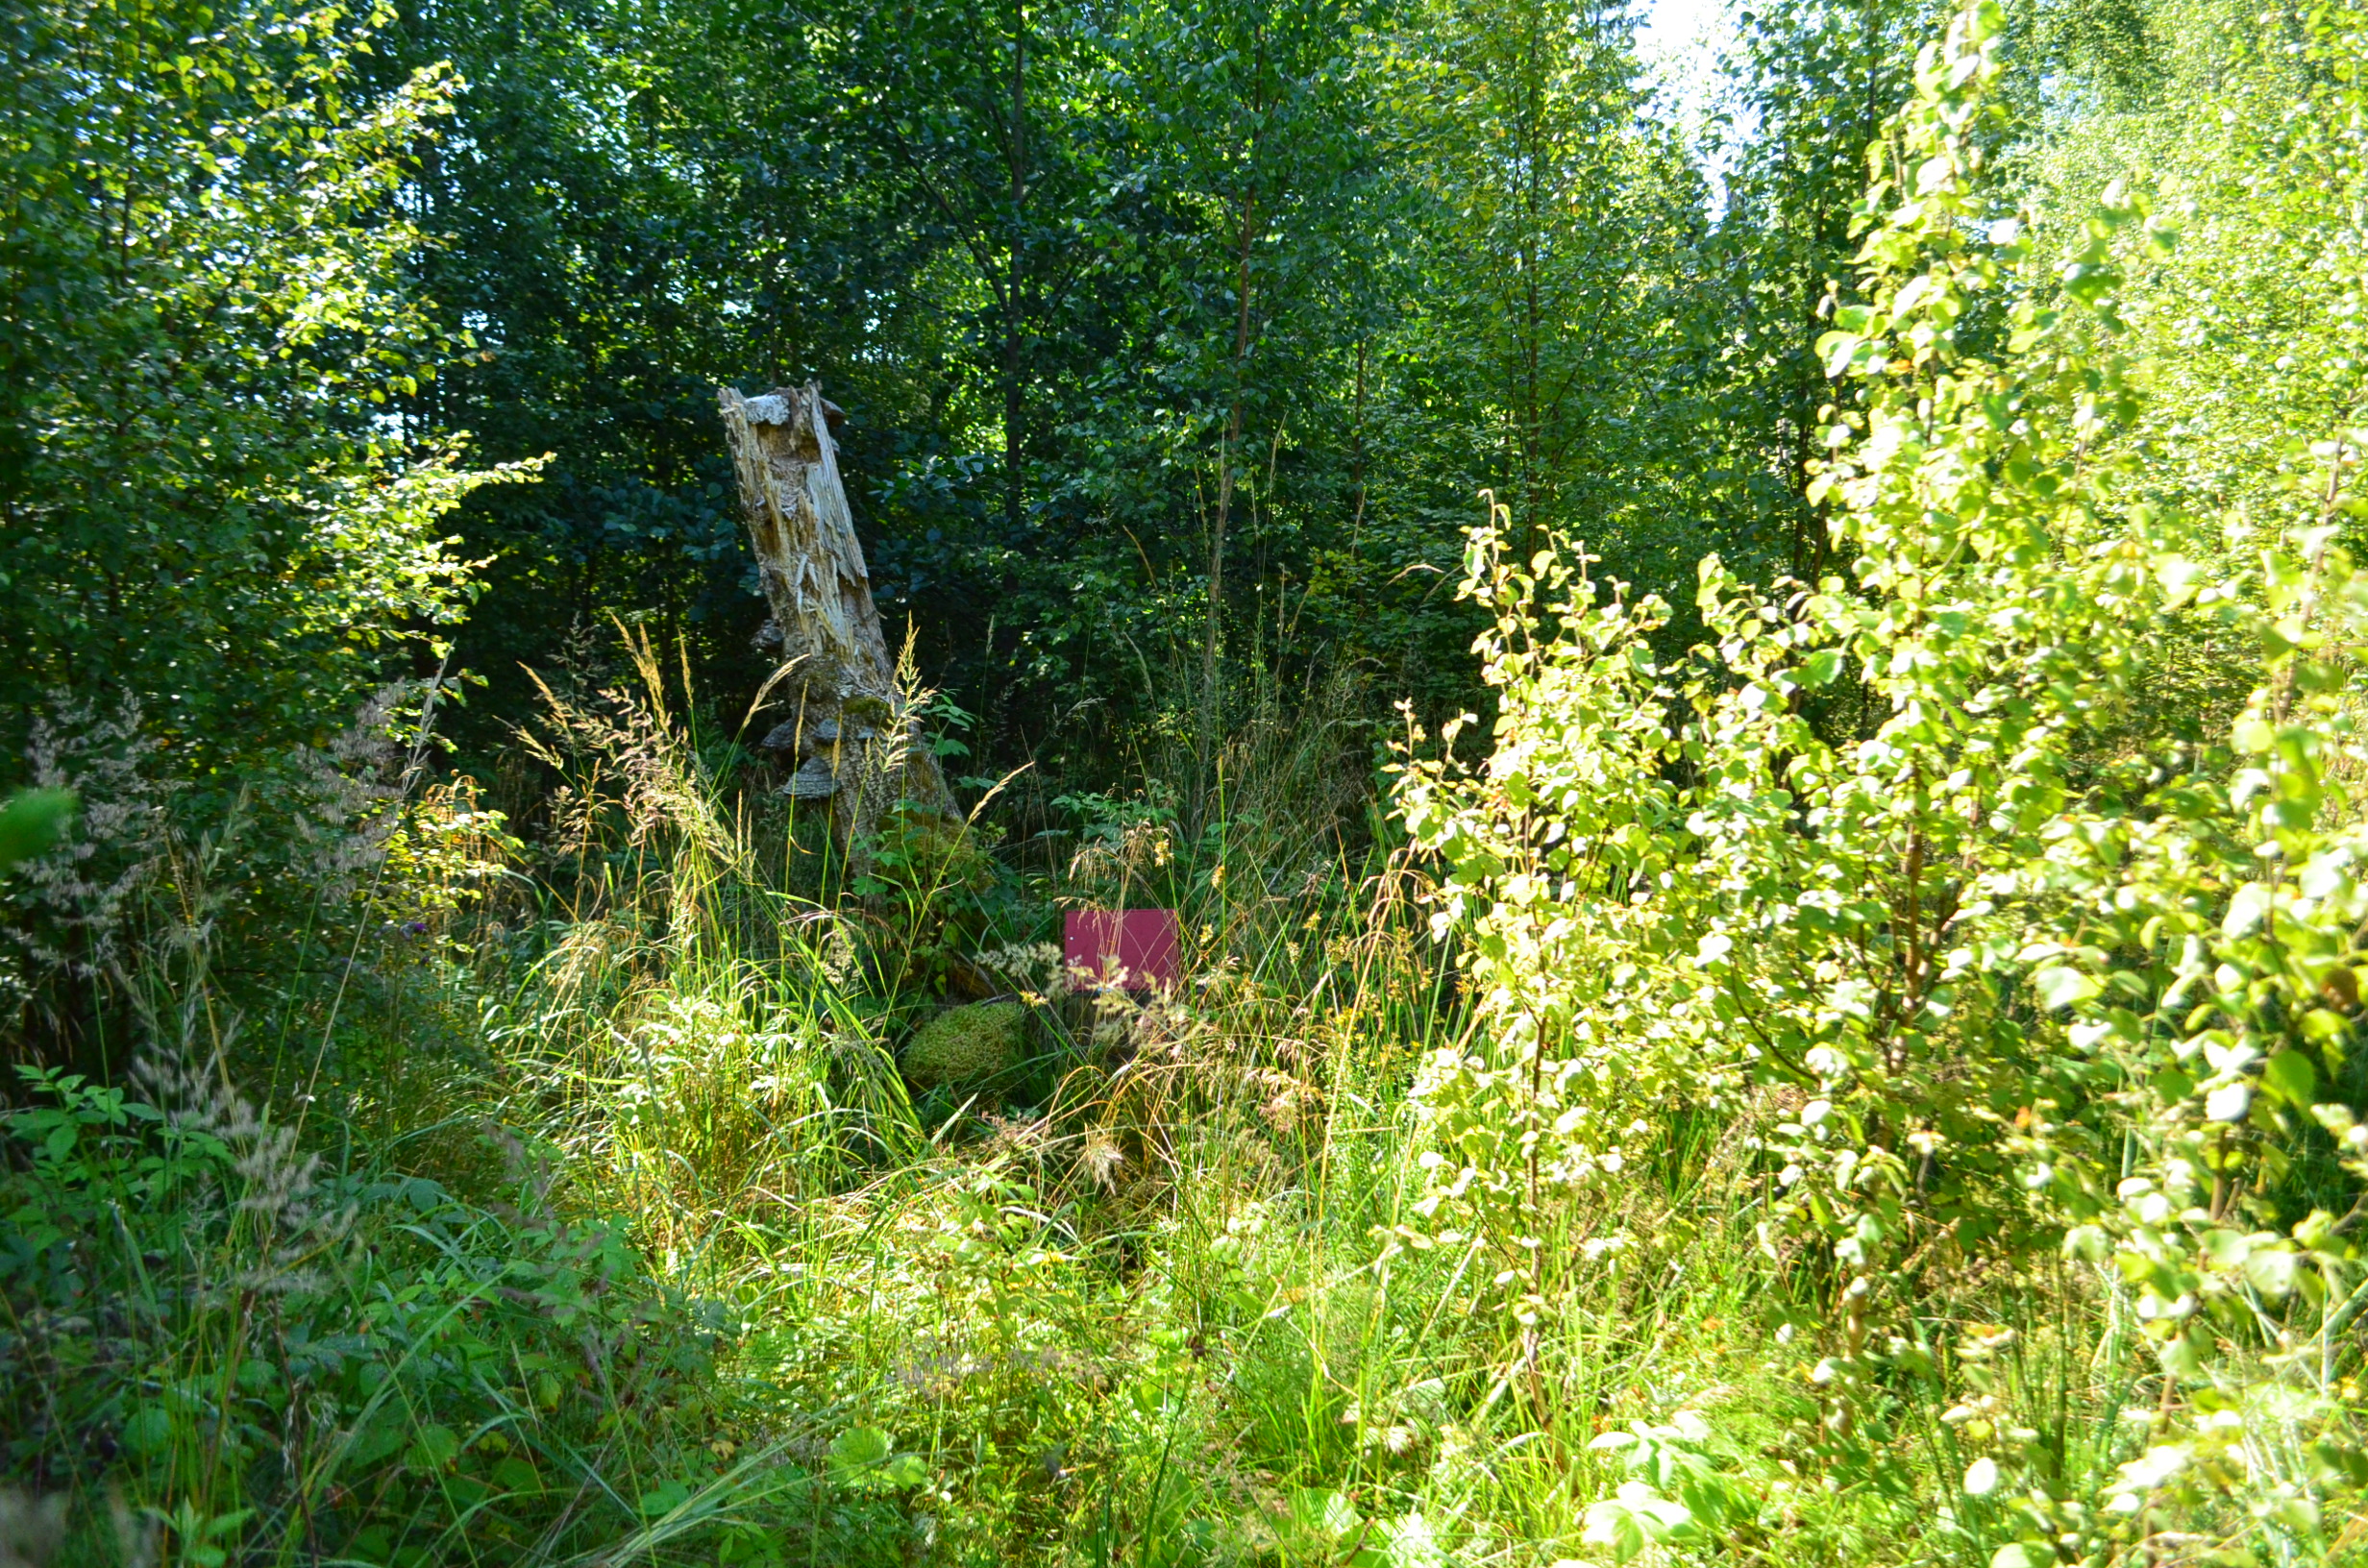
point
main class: Woodland
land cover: Spruce dominated mixed woodland
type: hemiboreal forest and nemoral coniferous forest and mixed broadleaved-coniferous forest
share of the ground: 50 - 75 %
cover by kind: broadleaved forest trees 30 %, shrubs 30 %, coniferous forest trees 25 %, herbaceous plants 15 %
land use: Forestry
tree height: < 5 m
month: August
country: LV
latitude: 57.3892
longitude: 22.3793
